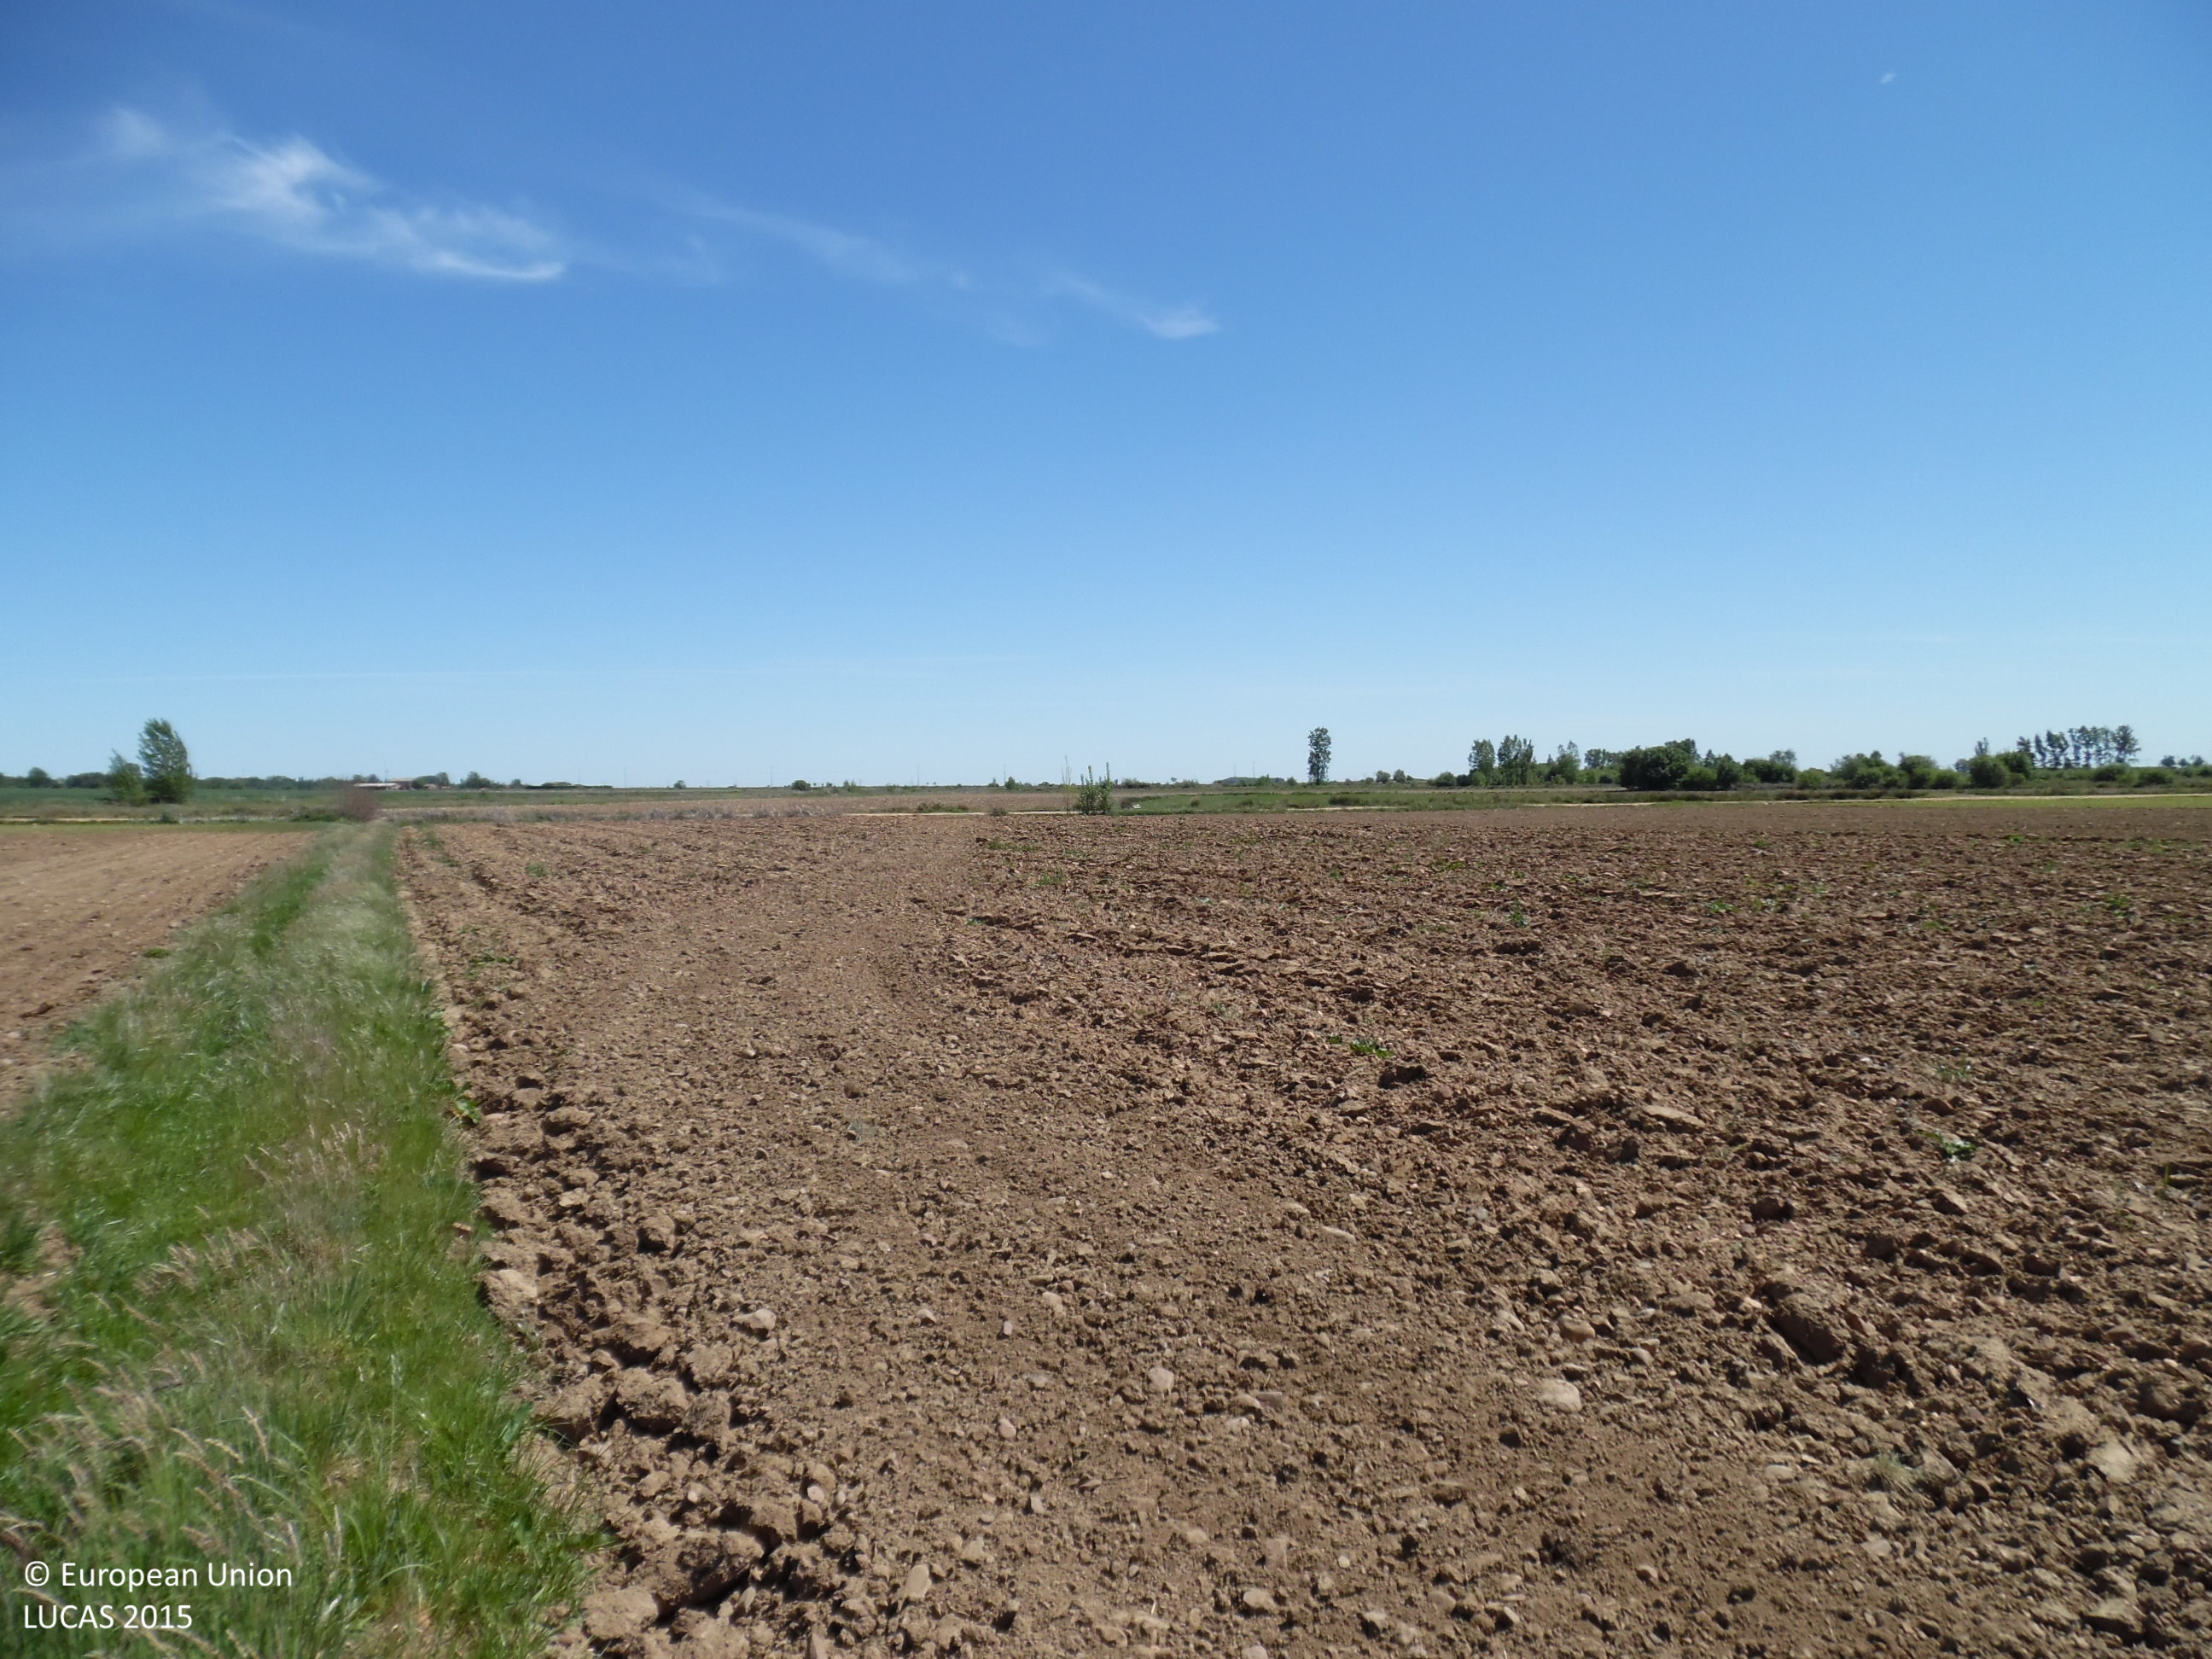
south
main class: Grassland
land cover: Grassland with sparse tree/shrub cover
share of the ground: 10 - 25 %
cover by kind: herbaceous plants 95 %, broadleaved forest trees 5 %
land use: Forestry
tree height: > 5 m
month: May
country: ES
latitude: 42.5262
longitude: -5.7927
